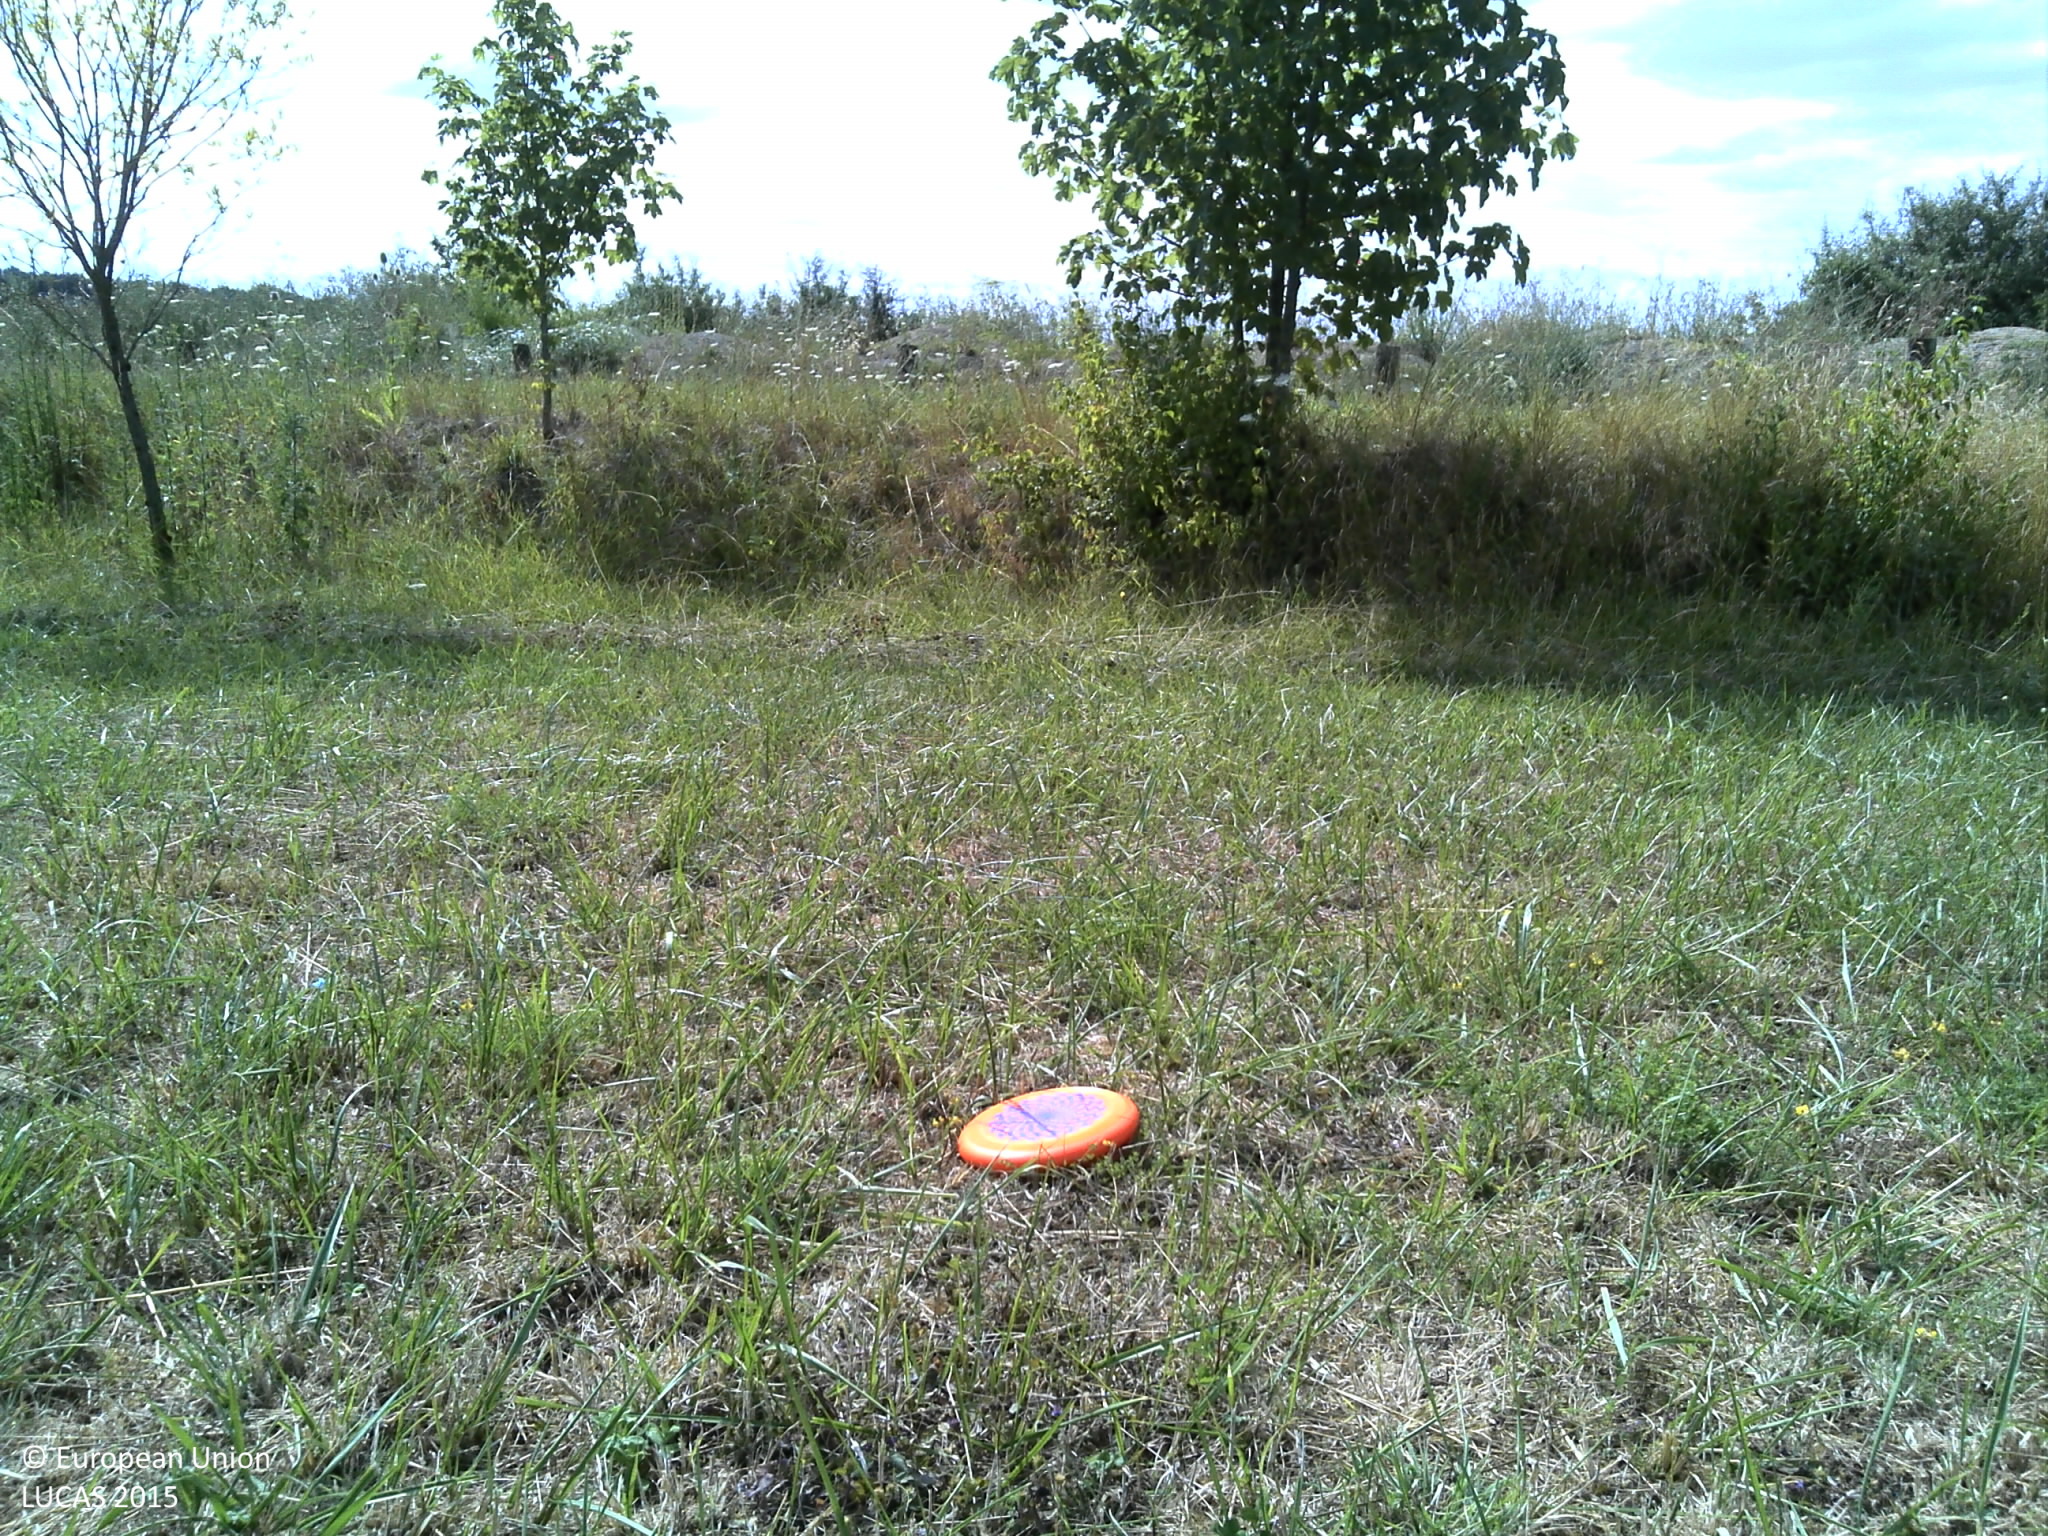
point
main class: Grassland
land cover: Grassland with sparse tree/shrub cover
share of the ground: > 75 %
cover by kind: herbaceous plants 85 %, shrubs 10 %, coniferous forest trees 5 %
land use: Amenities, museums, leisure
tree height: < 5 m
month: July
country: FR
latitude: 48.6174
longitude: 4.6664
